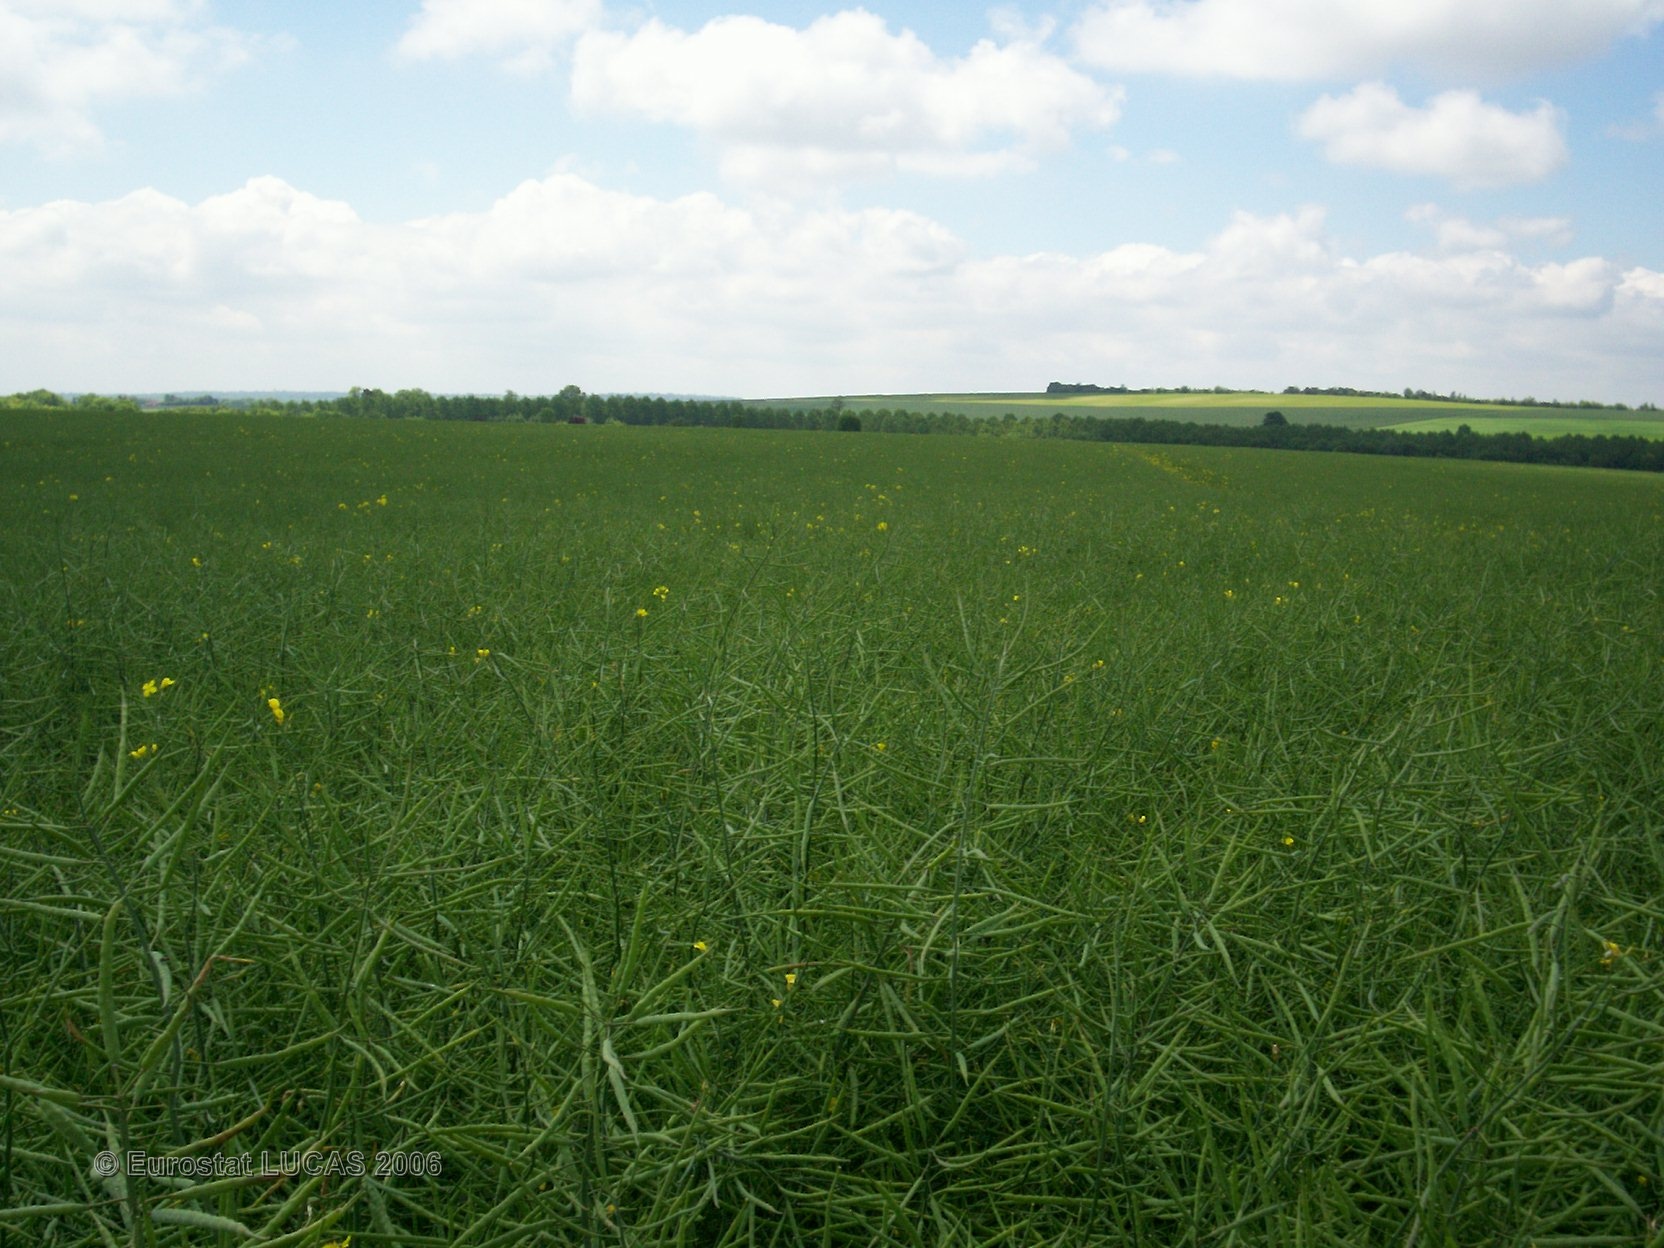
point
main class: Cropland
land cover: Rape and turnip rape
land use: Agriculture (excluding fallow land and kitchen gardens)
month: June
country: FR
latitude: 48.6234
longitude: 4.4210
